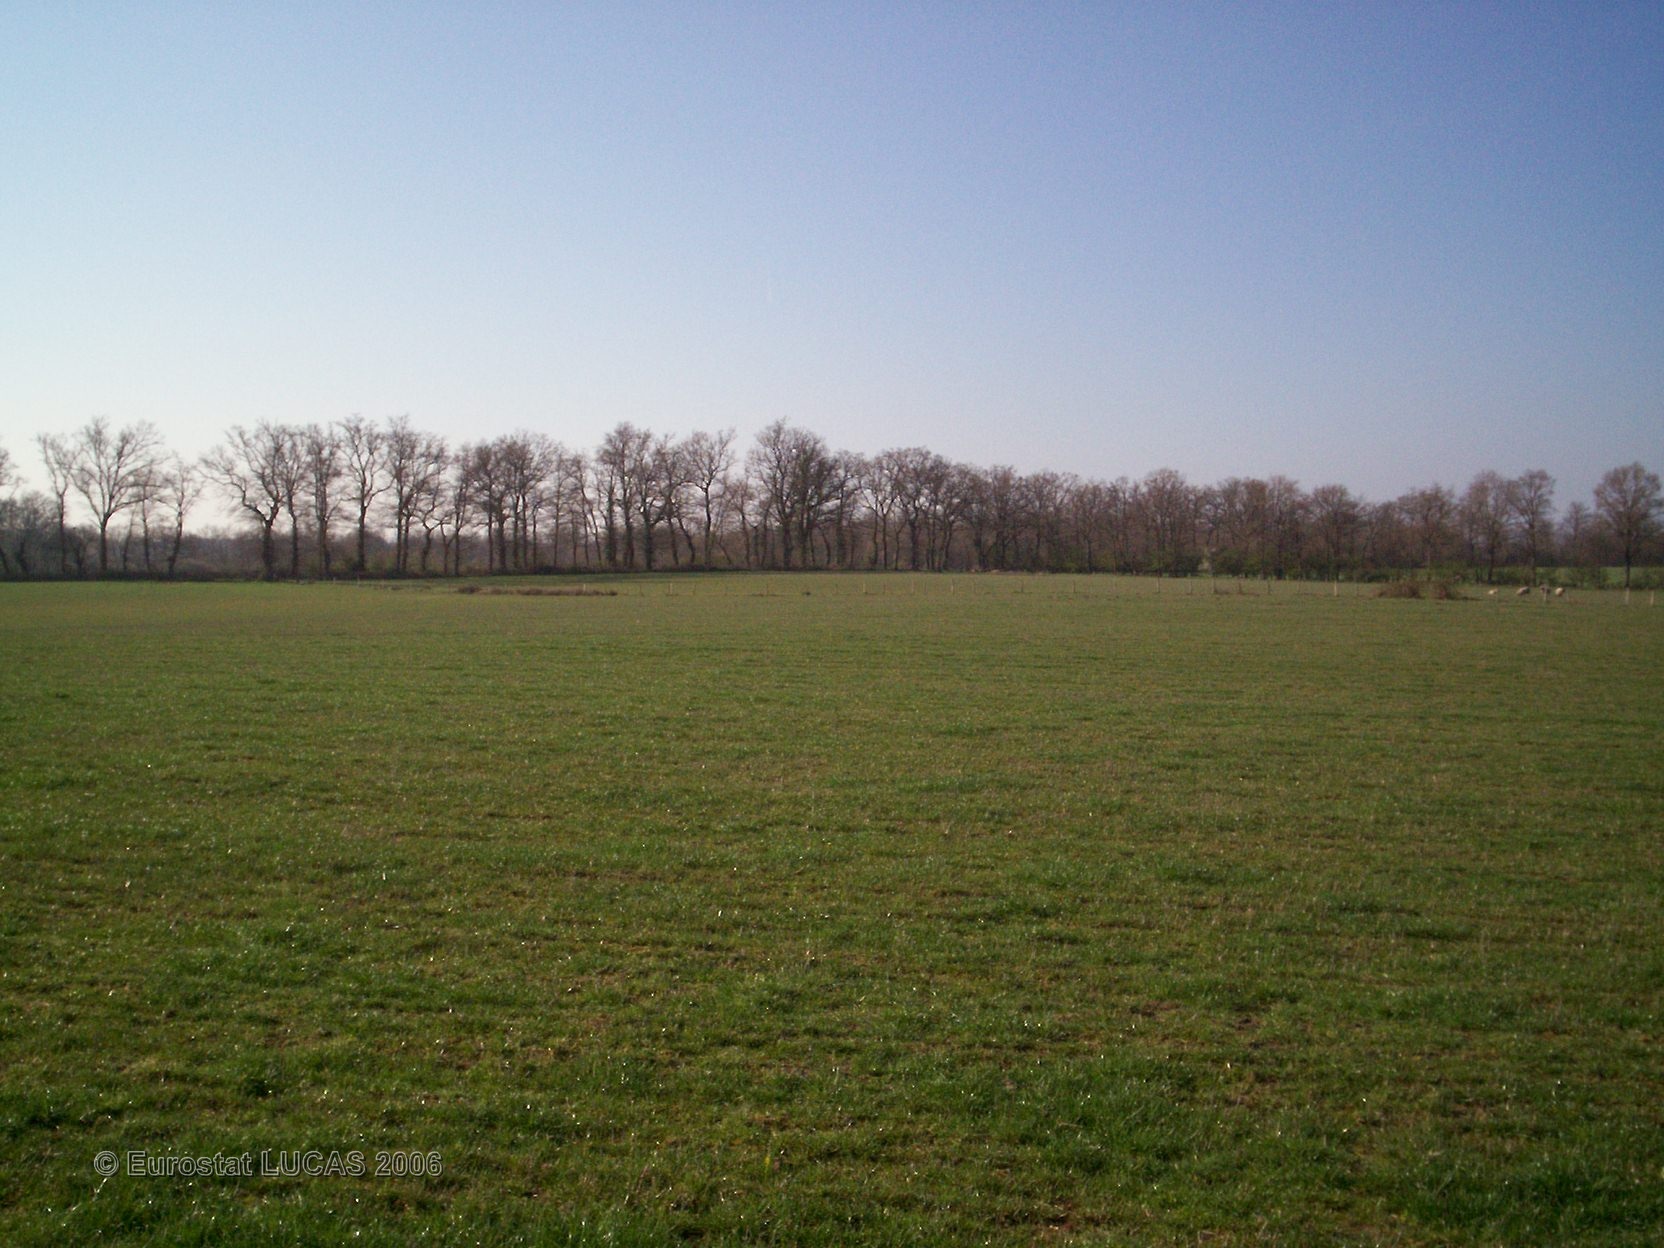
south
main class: Grassland
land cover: Grassland without tree/shrub cover
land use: Agriculture (excluding fallow land and kitchen gardens)
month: April
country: FR
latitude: 46.3230
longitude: 1.0908
